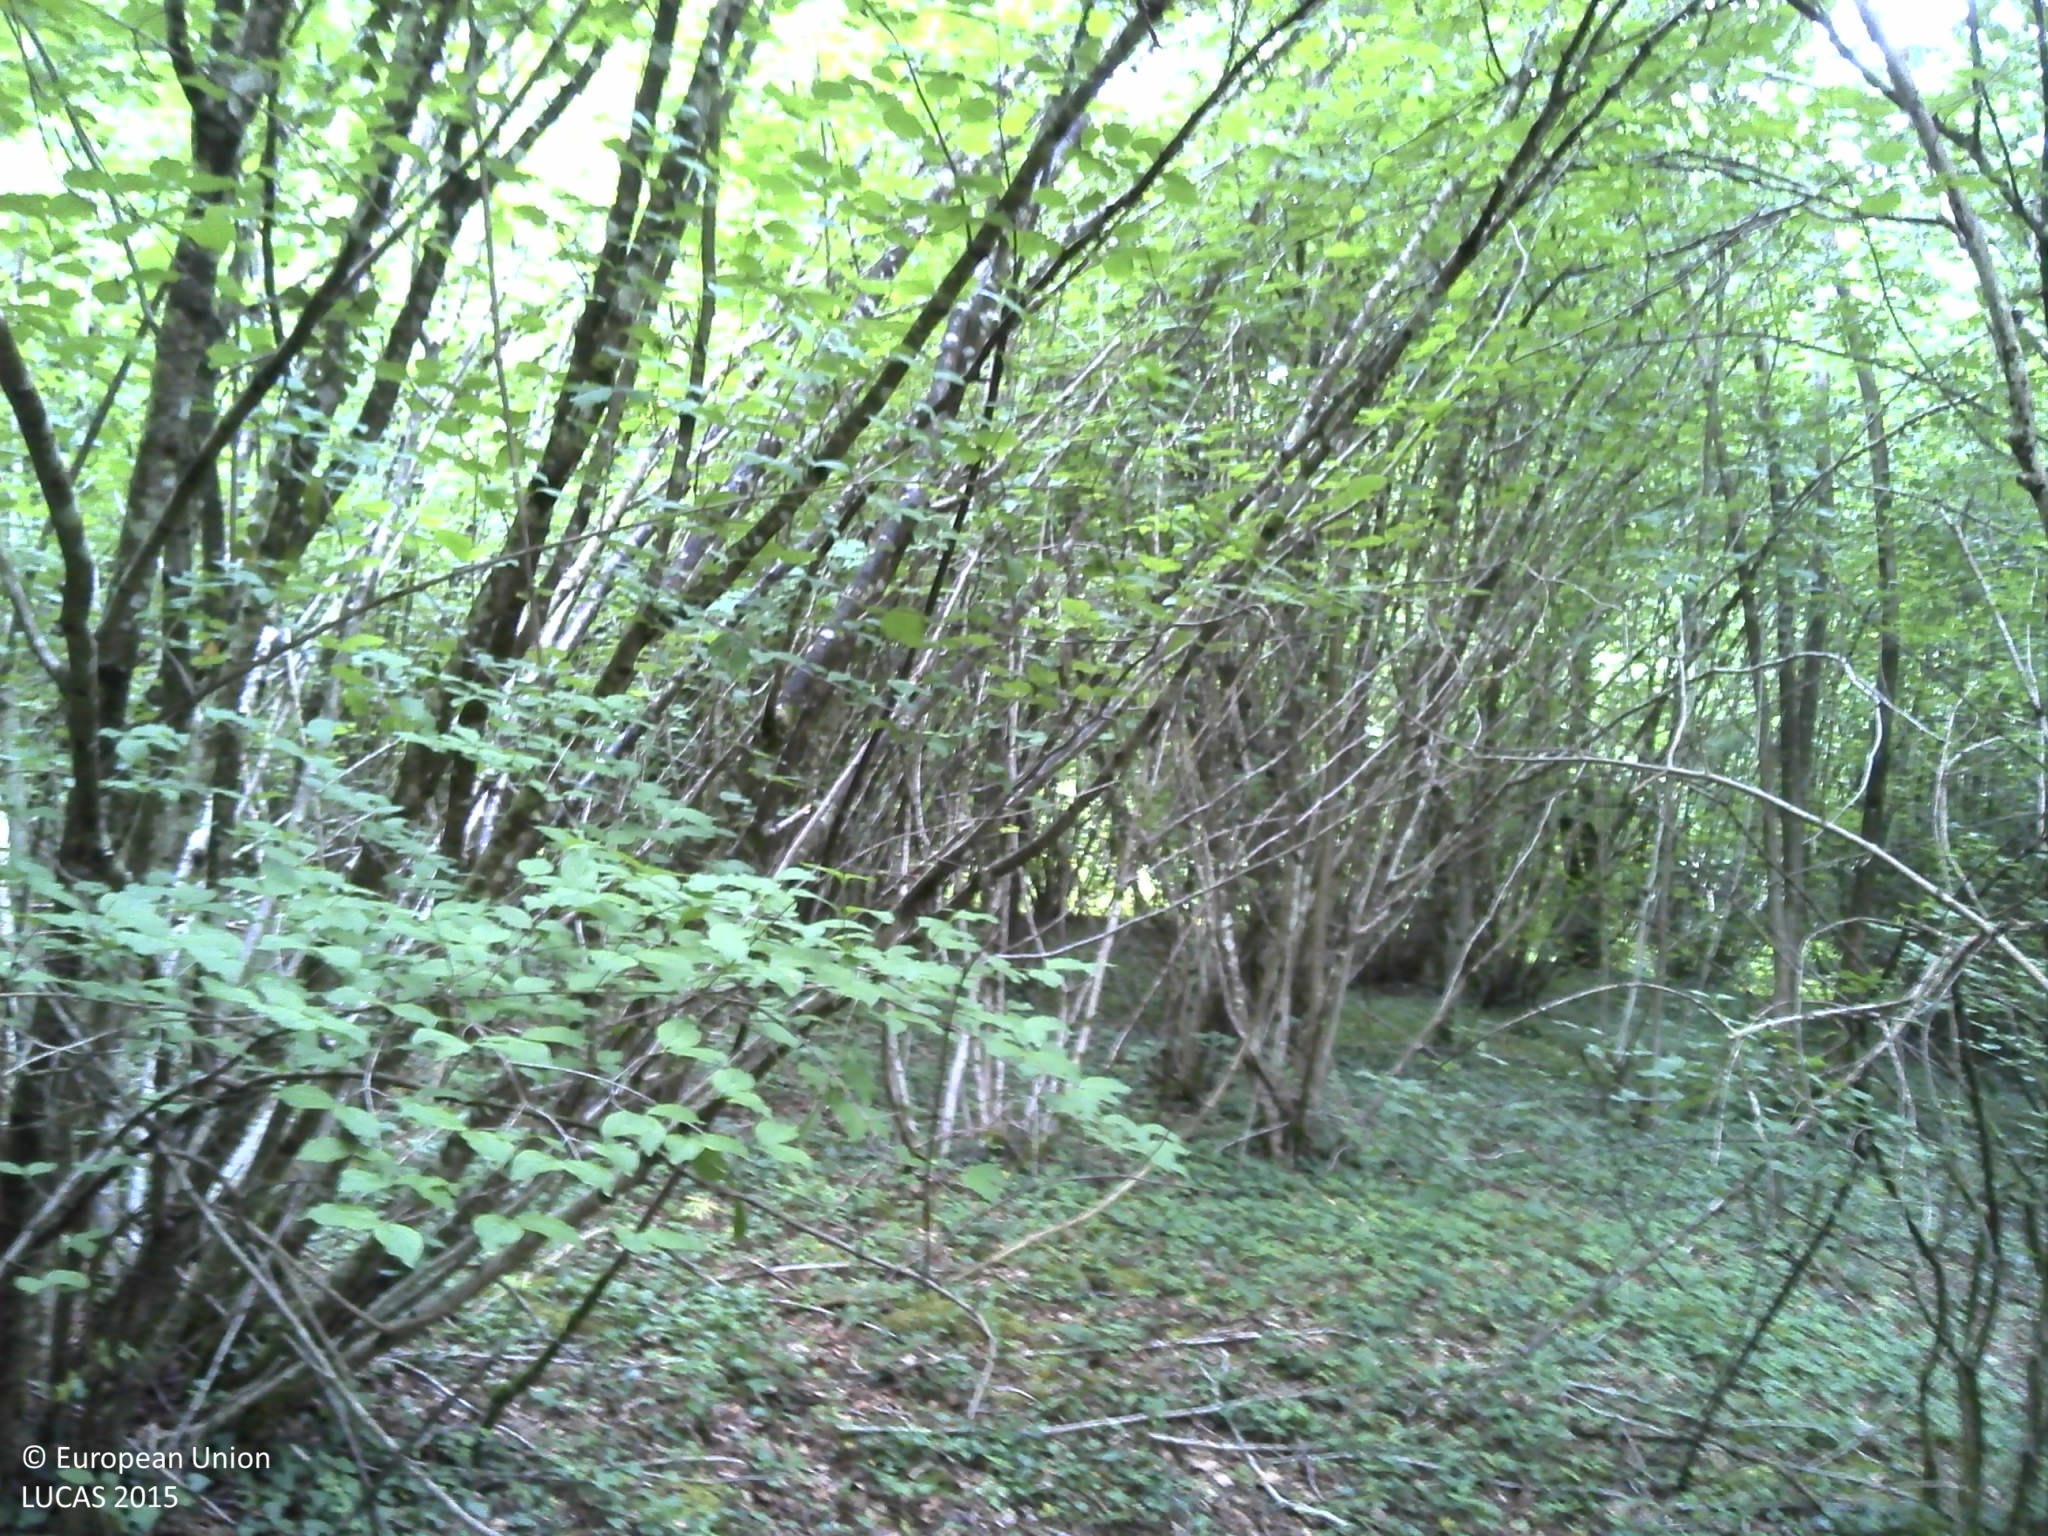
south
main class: Woodland
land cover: Broadleaved woodland
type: beech forest
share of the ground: 50 - 75 %
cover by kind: broadleaved forest trees 70 %, herbaceous plants 20 %, consolidated bare surface 10 %
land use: Forestry
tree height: > 5 m
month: June
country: FR
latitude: 49.6321
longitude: 4.7772
